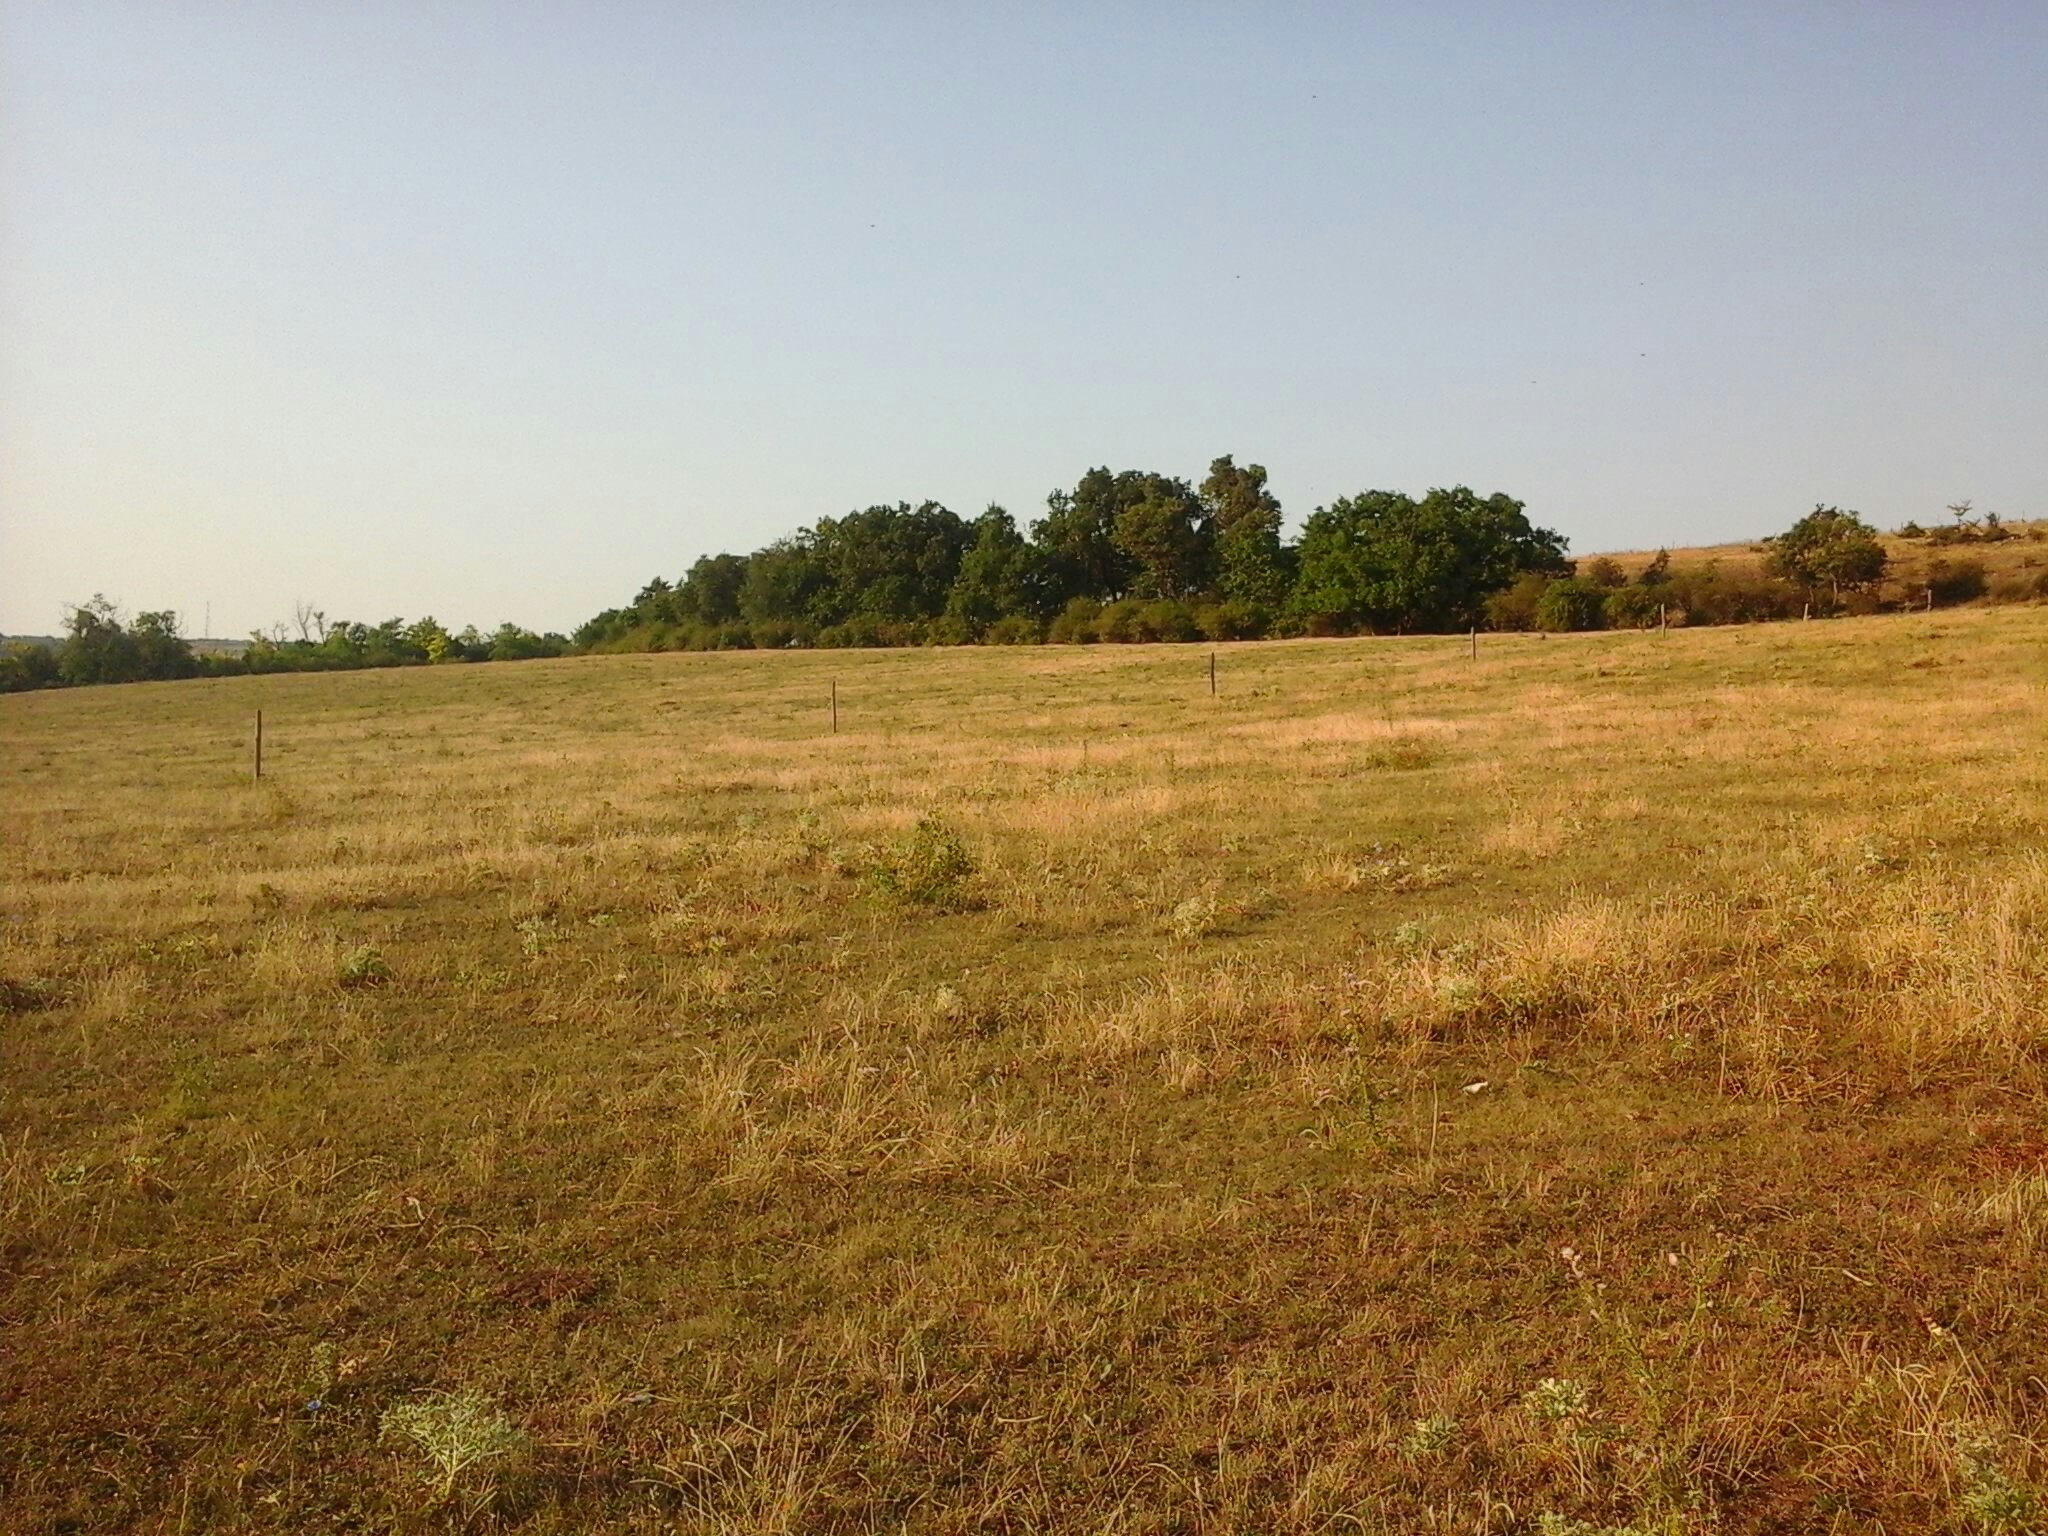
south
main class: Grassland
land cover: Grassland without tree/shrub cover
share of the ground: > 75 %
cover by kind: herbaceous plants 100 %
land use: Agriculture (excluding fallow land and kitchen gardens)
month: August
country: HU
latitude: 47.2432
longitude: 18.2684
